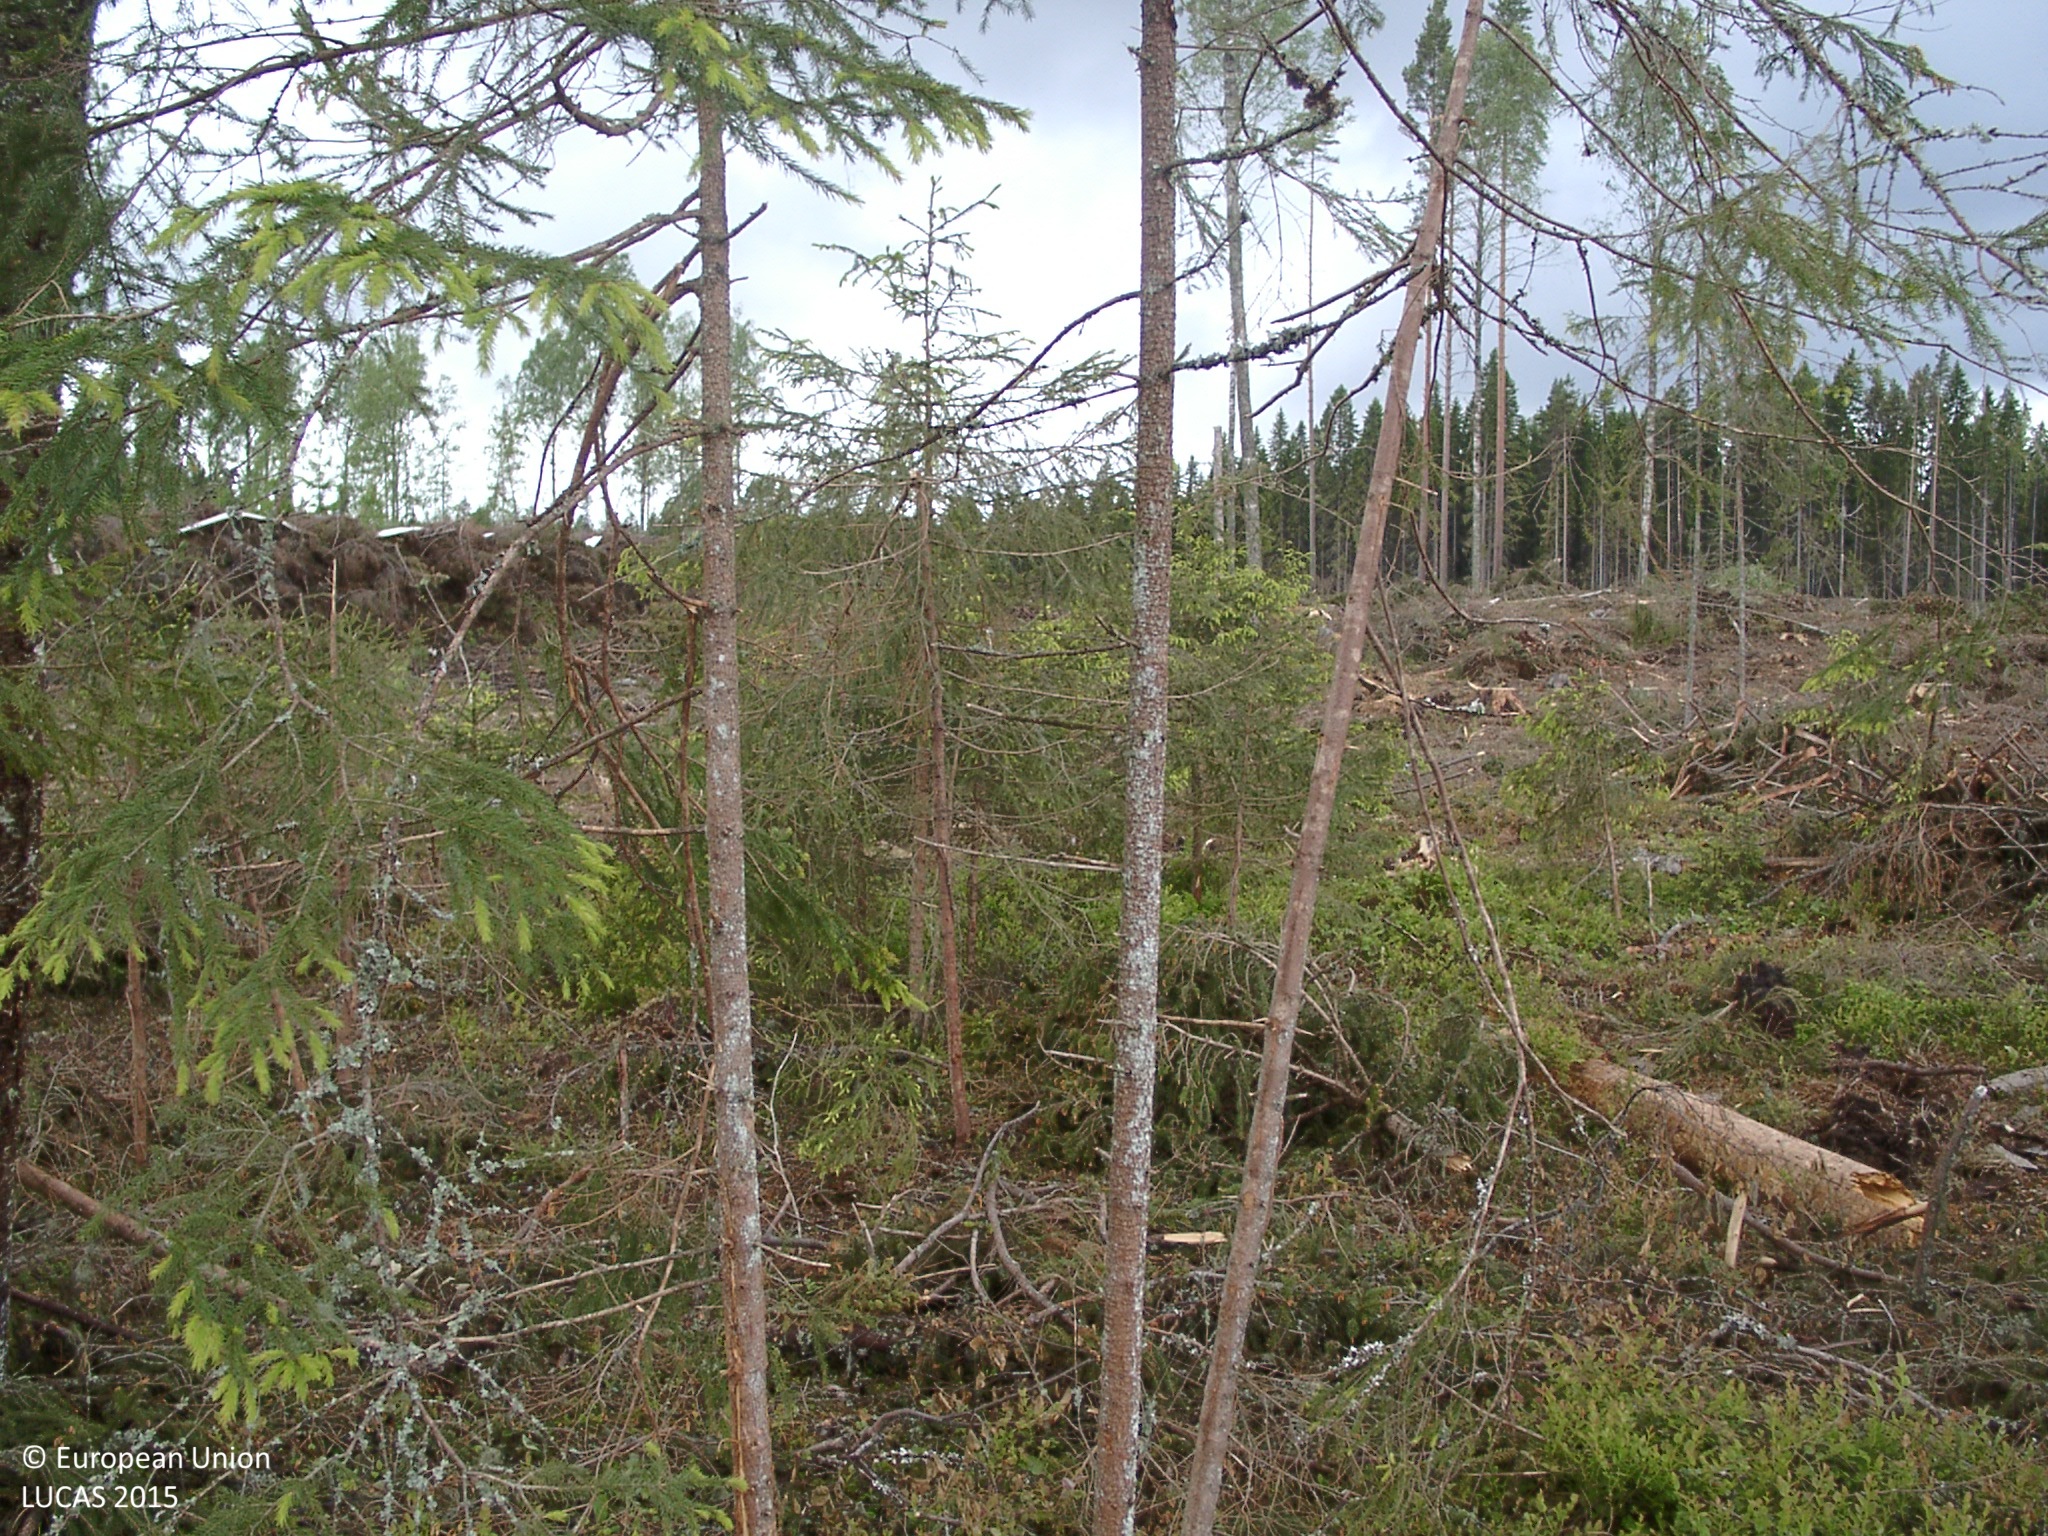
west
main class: Shrubland
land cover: Shrubland with sparse tree cover
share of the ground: 10 - 25 %
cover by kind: unconsolidated bare surface 50 %, shrubs 10 %, broadleaved forest trees 5 %
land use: Forestry
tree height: > 5 m
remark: Clear cut
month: June
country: FI
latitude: 61.5792
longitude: 24.8144
